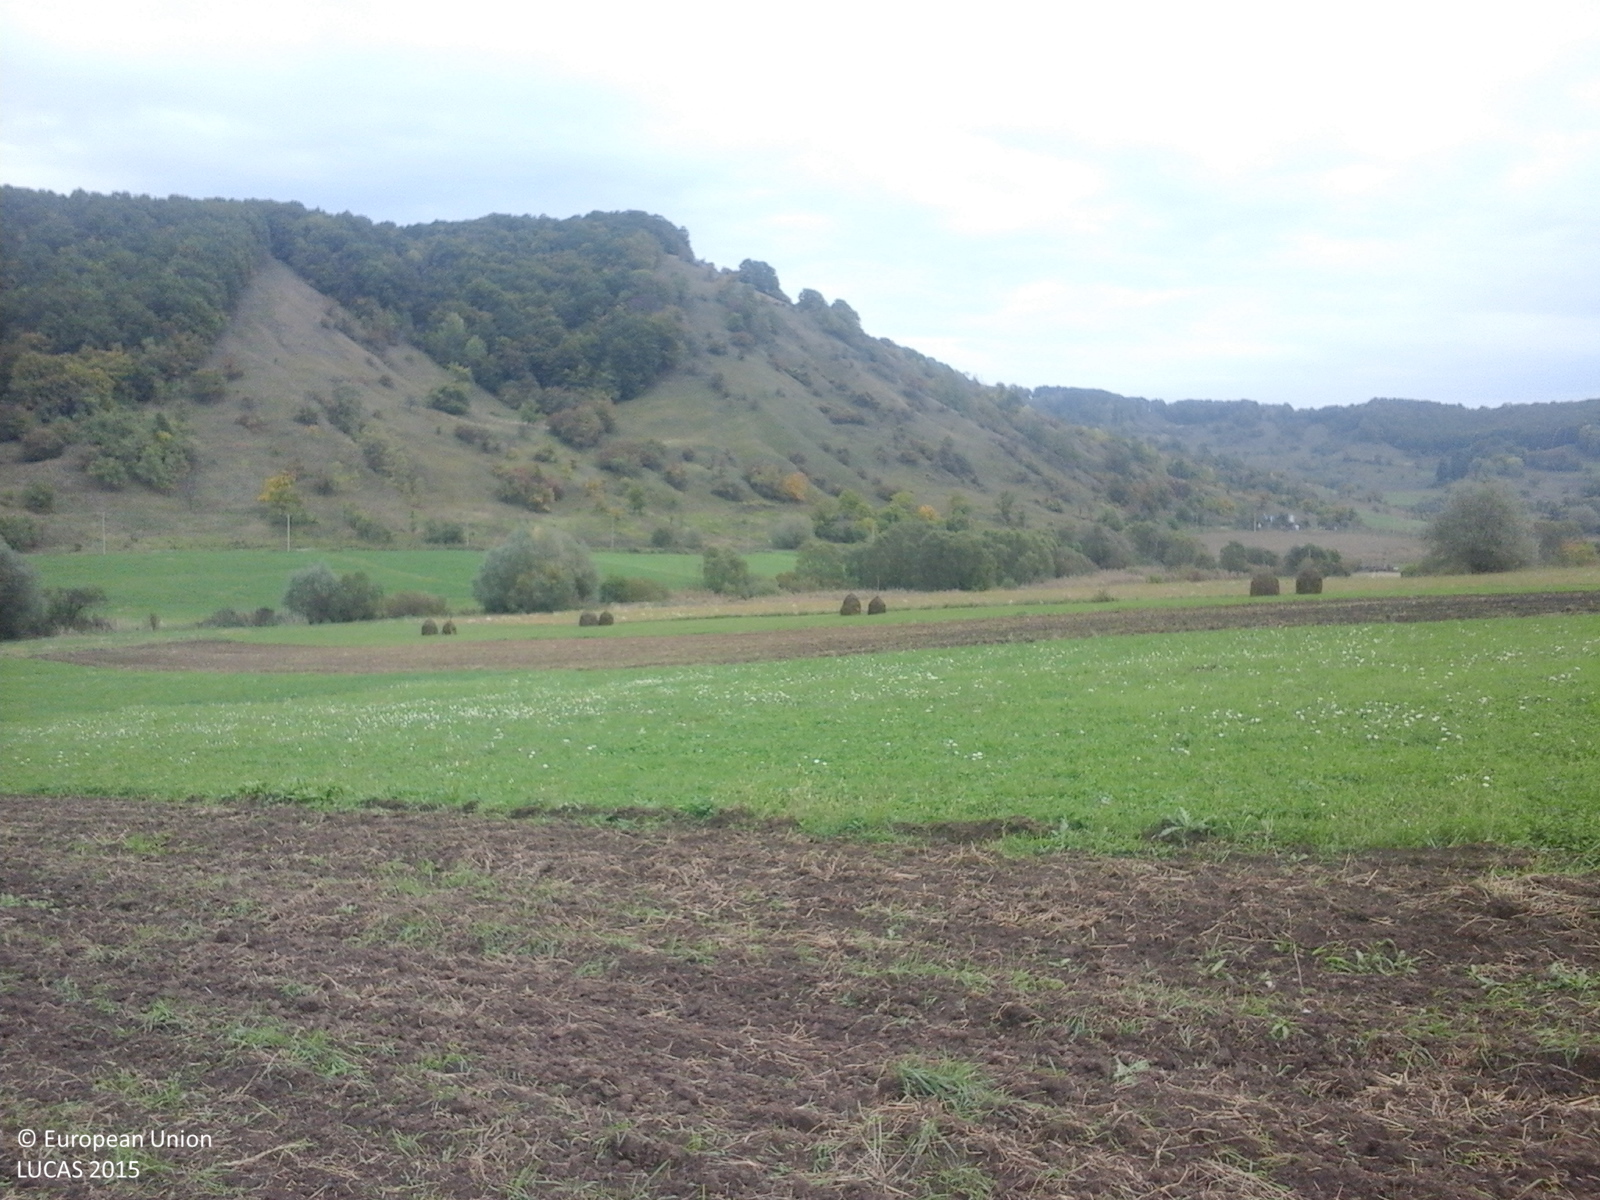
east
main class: Cropland
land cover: Common wheat
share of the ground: < 10 %
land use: Agriculture (excluding fallow land and kitchen gardens)
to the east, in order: Common wheat; Lucerne; Common wheat; Lucerne; Grassland without tree/shrub cover; Tracks; Lucerne; Inland marshes; Broadleaved woodland
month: October
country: RO
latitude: 46.5453
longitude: 24.8971
